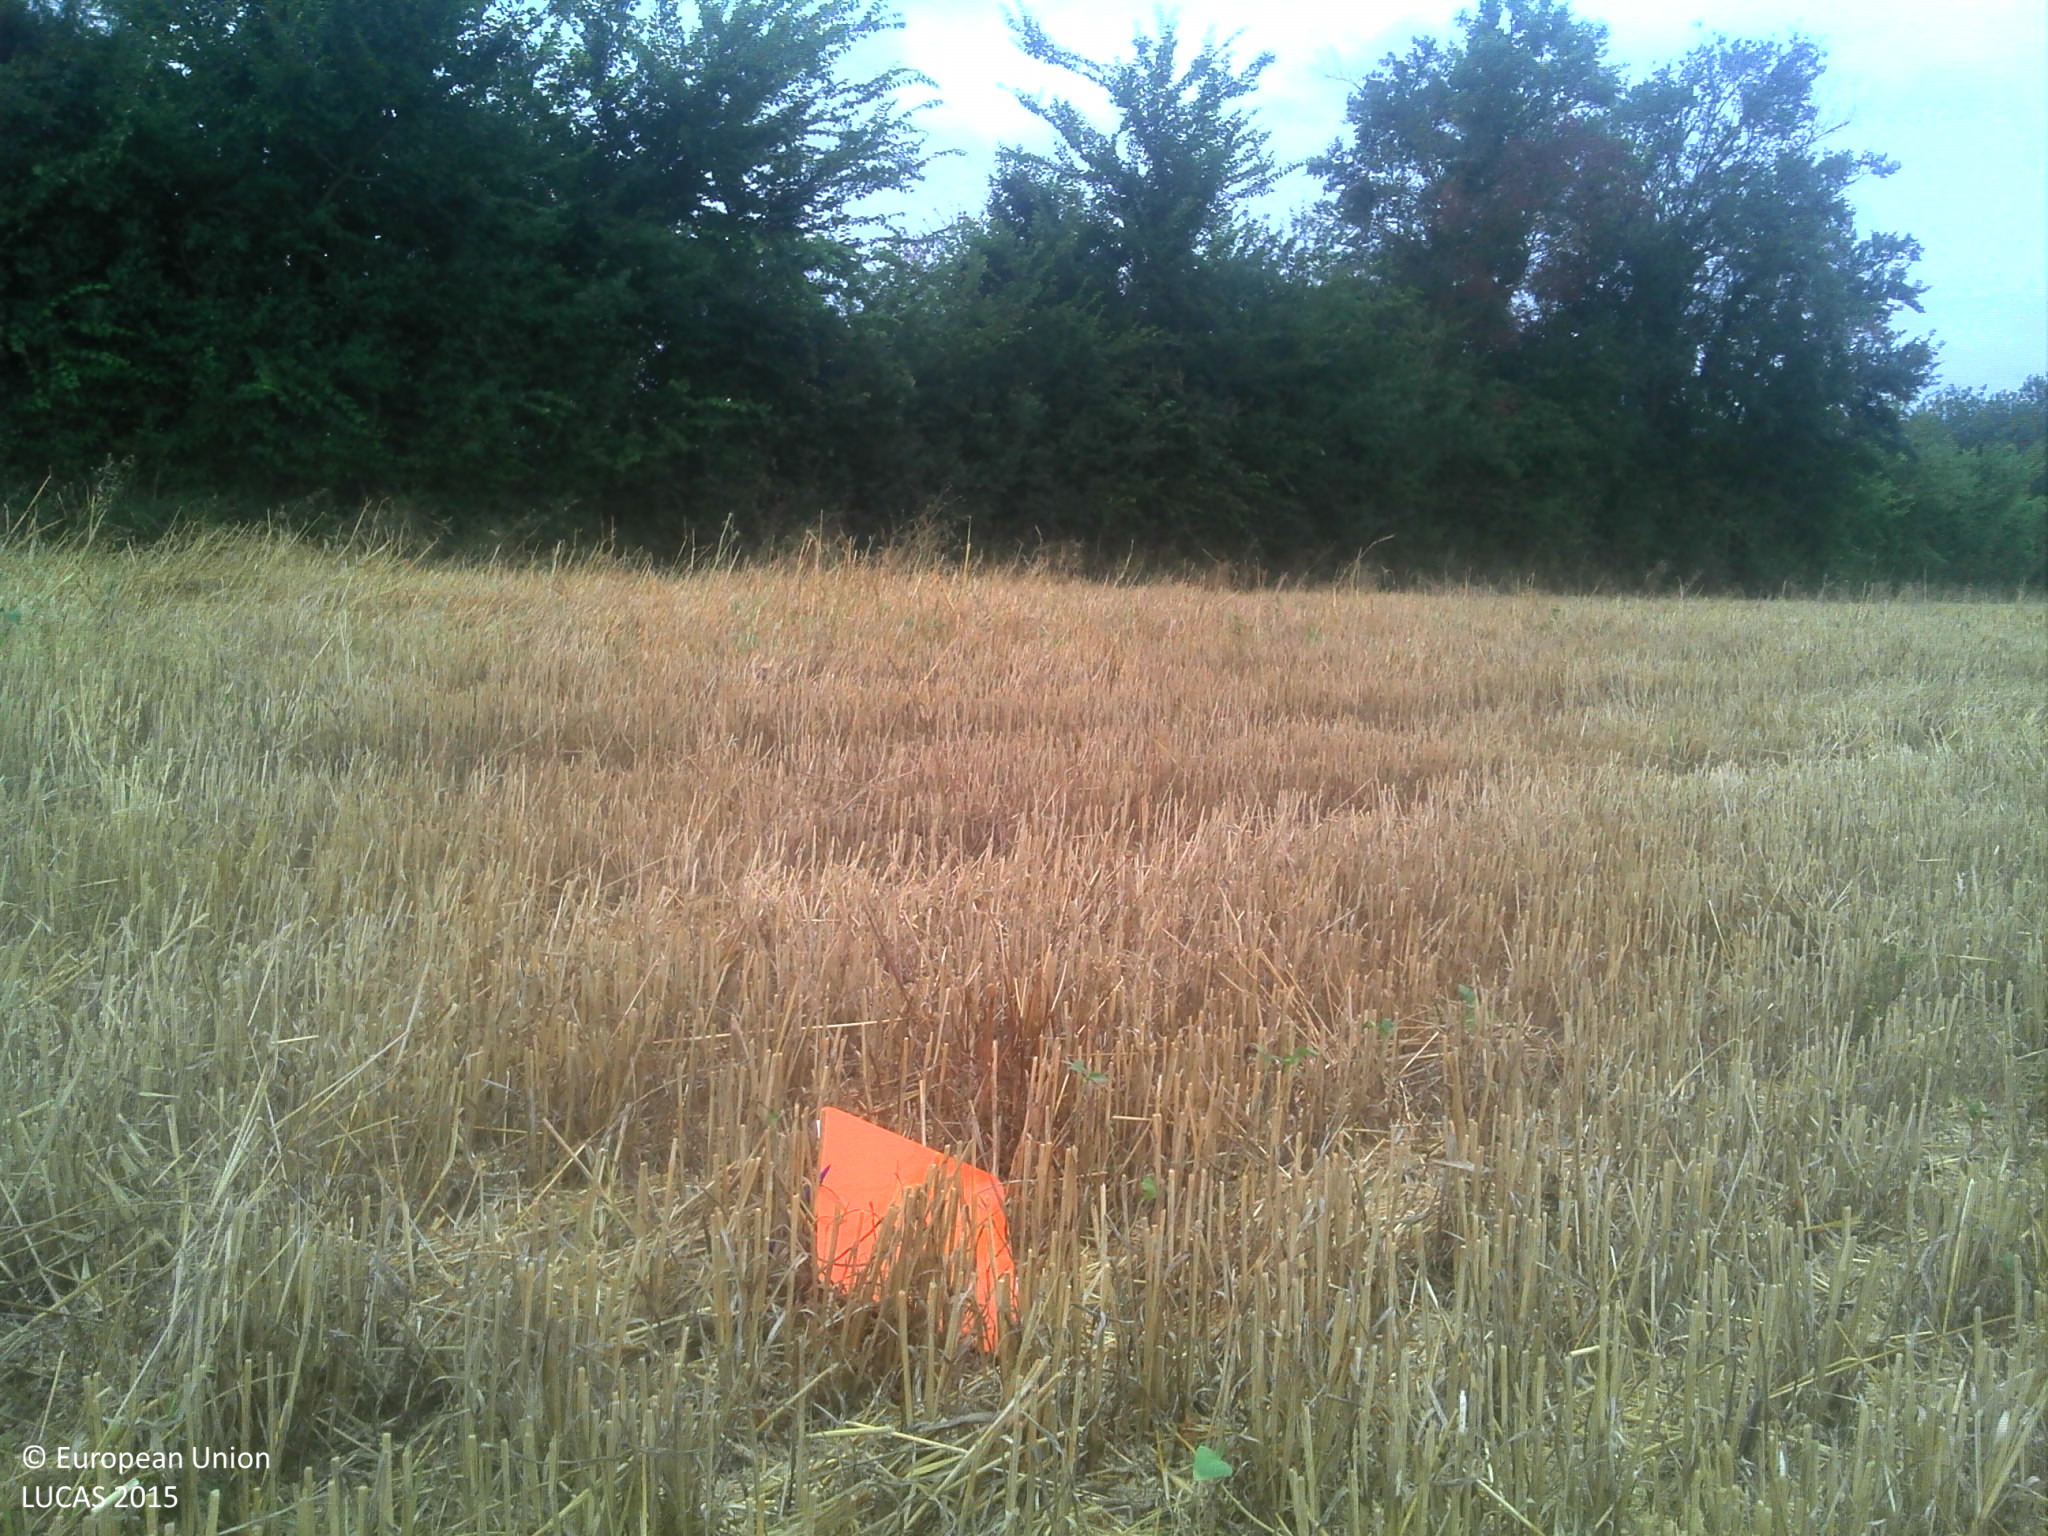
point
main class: Cropland
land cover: Common wheat
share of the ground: > 75 %
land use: Agriculture (excluding fallow land and kitchen gardens)
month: July
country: FR
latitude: 43.3448
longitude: 1.4553
